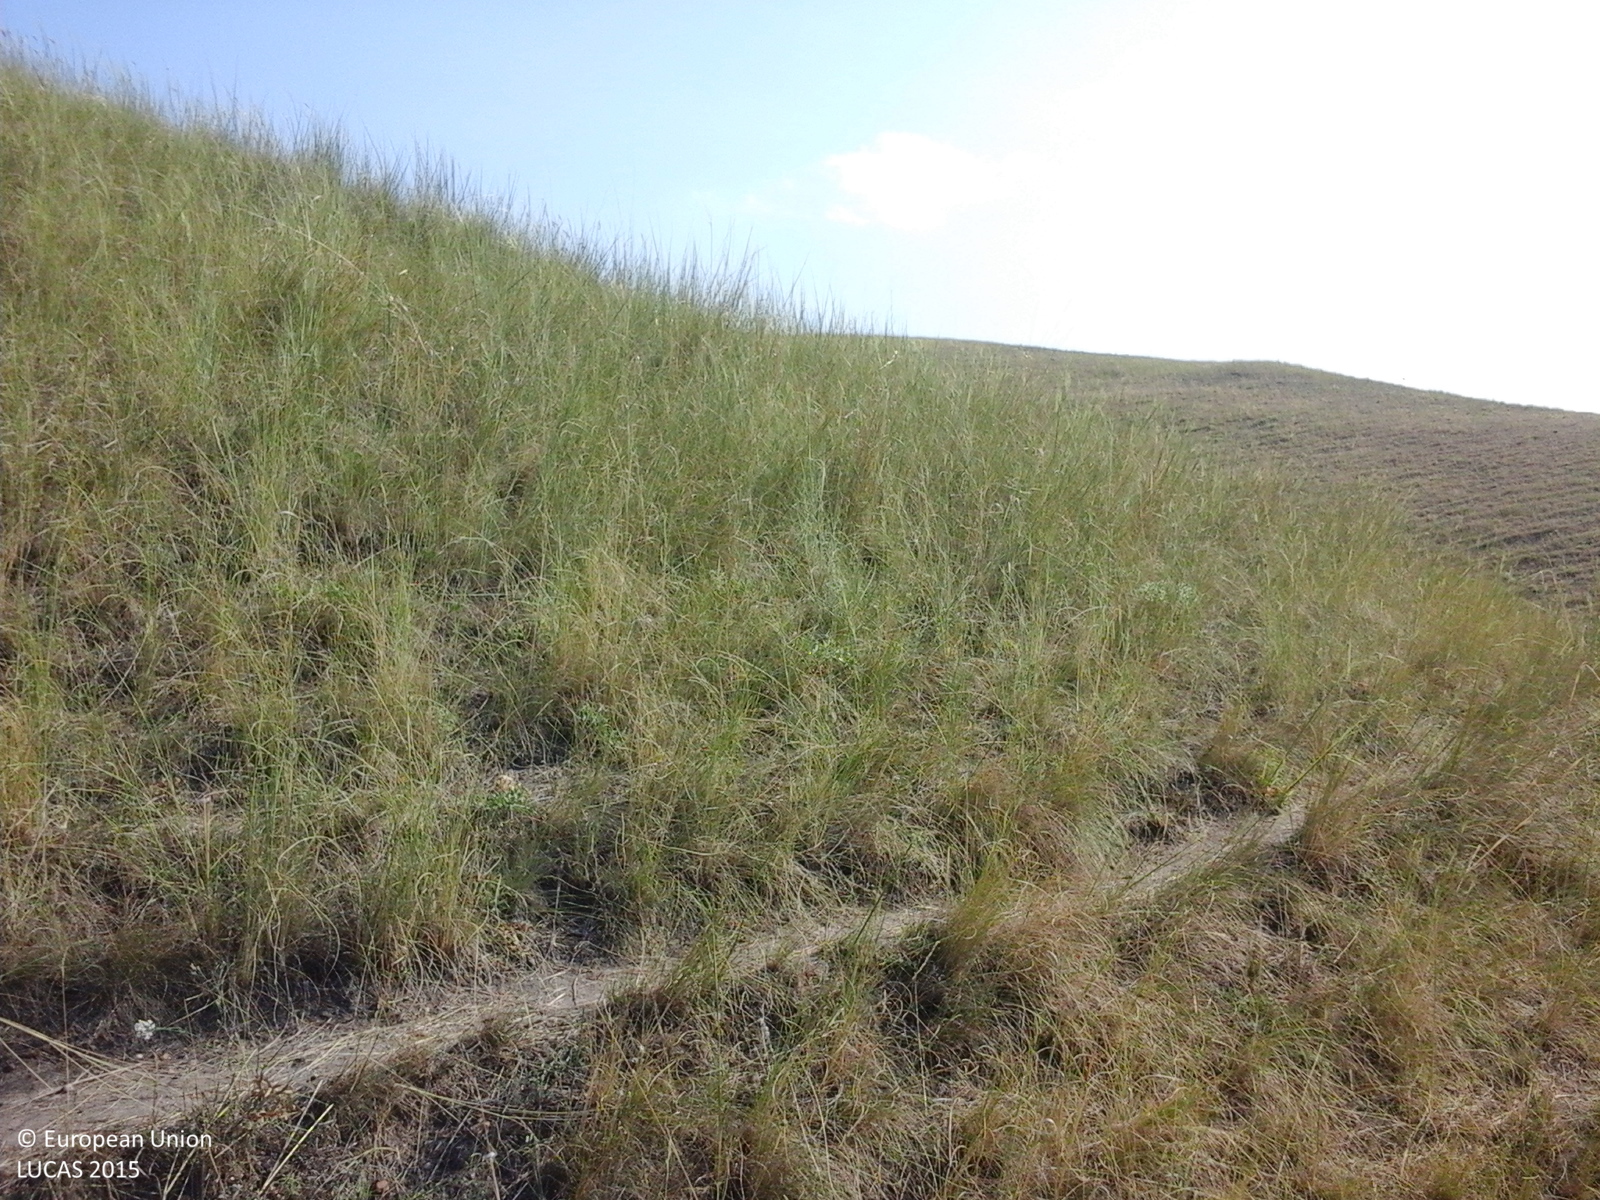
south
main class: Grassland
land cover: Grassland without tree/shrub cover
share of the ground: > 75 %
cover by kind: herbaceous plants 100 %
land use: Agriculture (excluding fallow land and kitchen gardens)
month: July
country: RO
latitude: 45.9598
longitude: 27.5130
